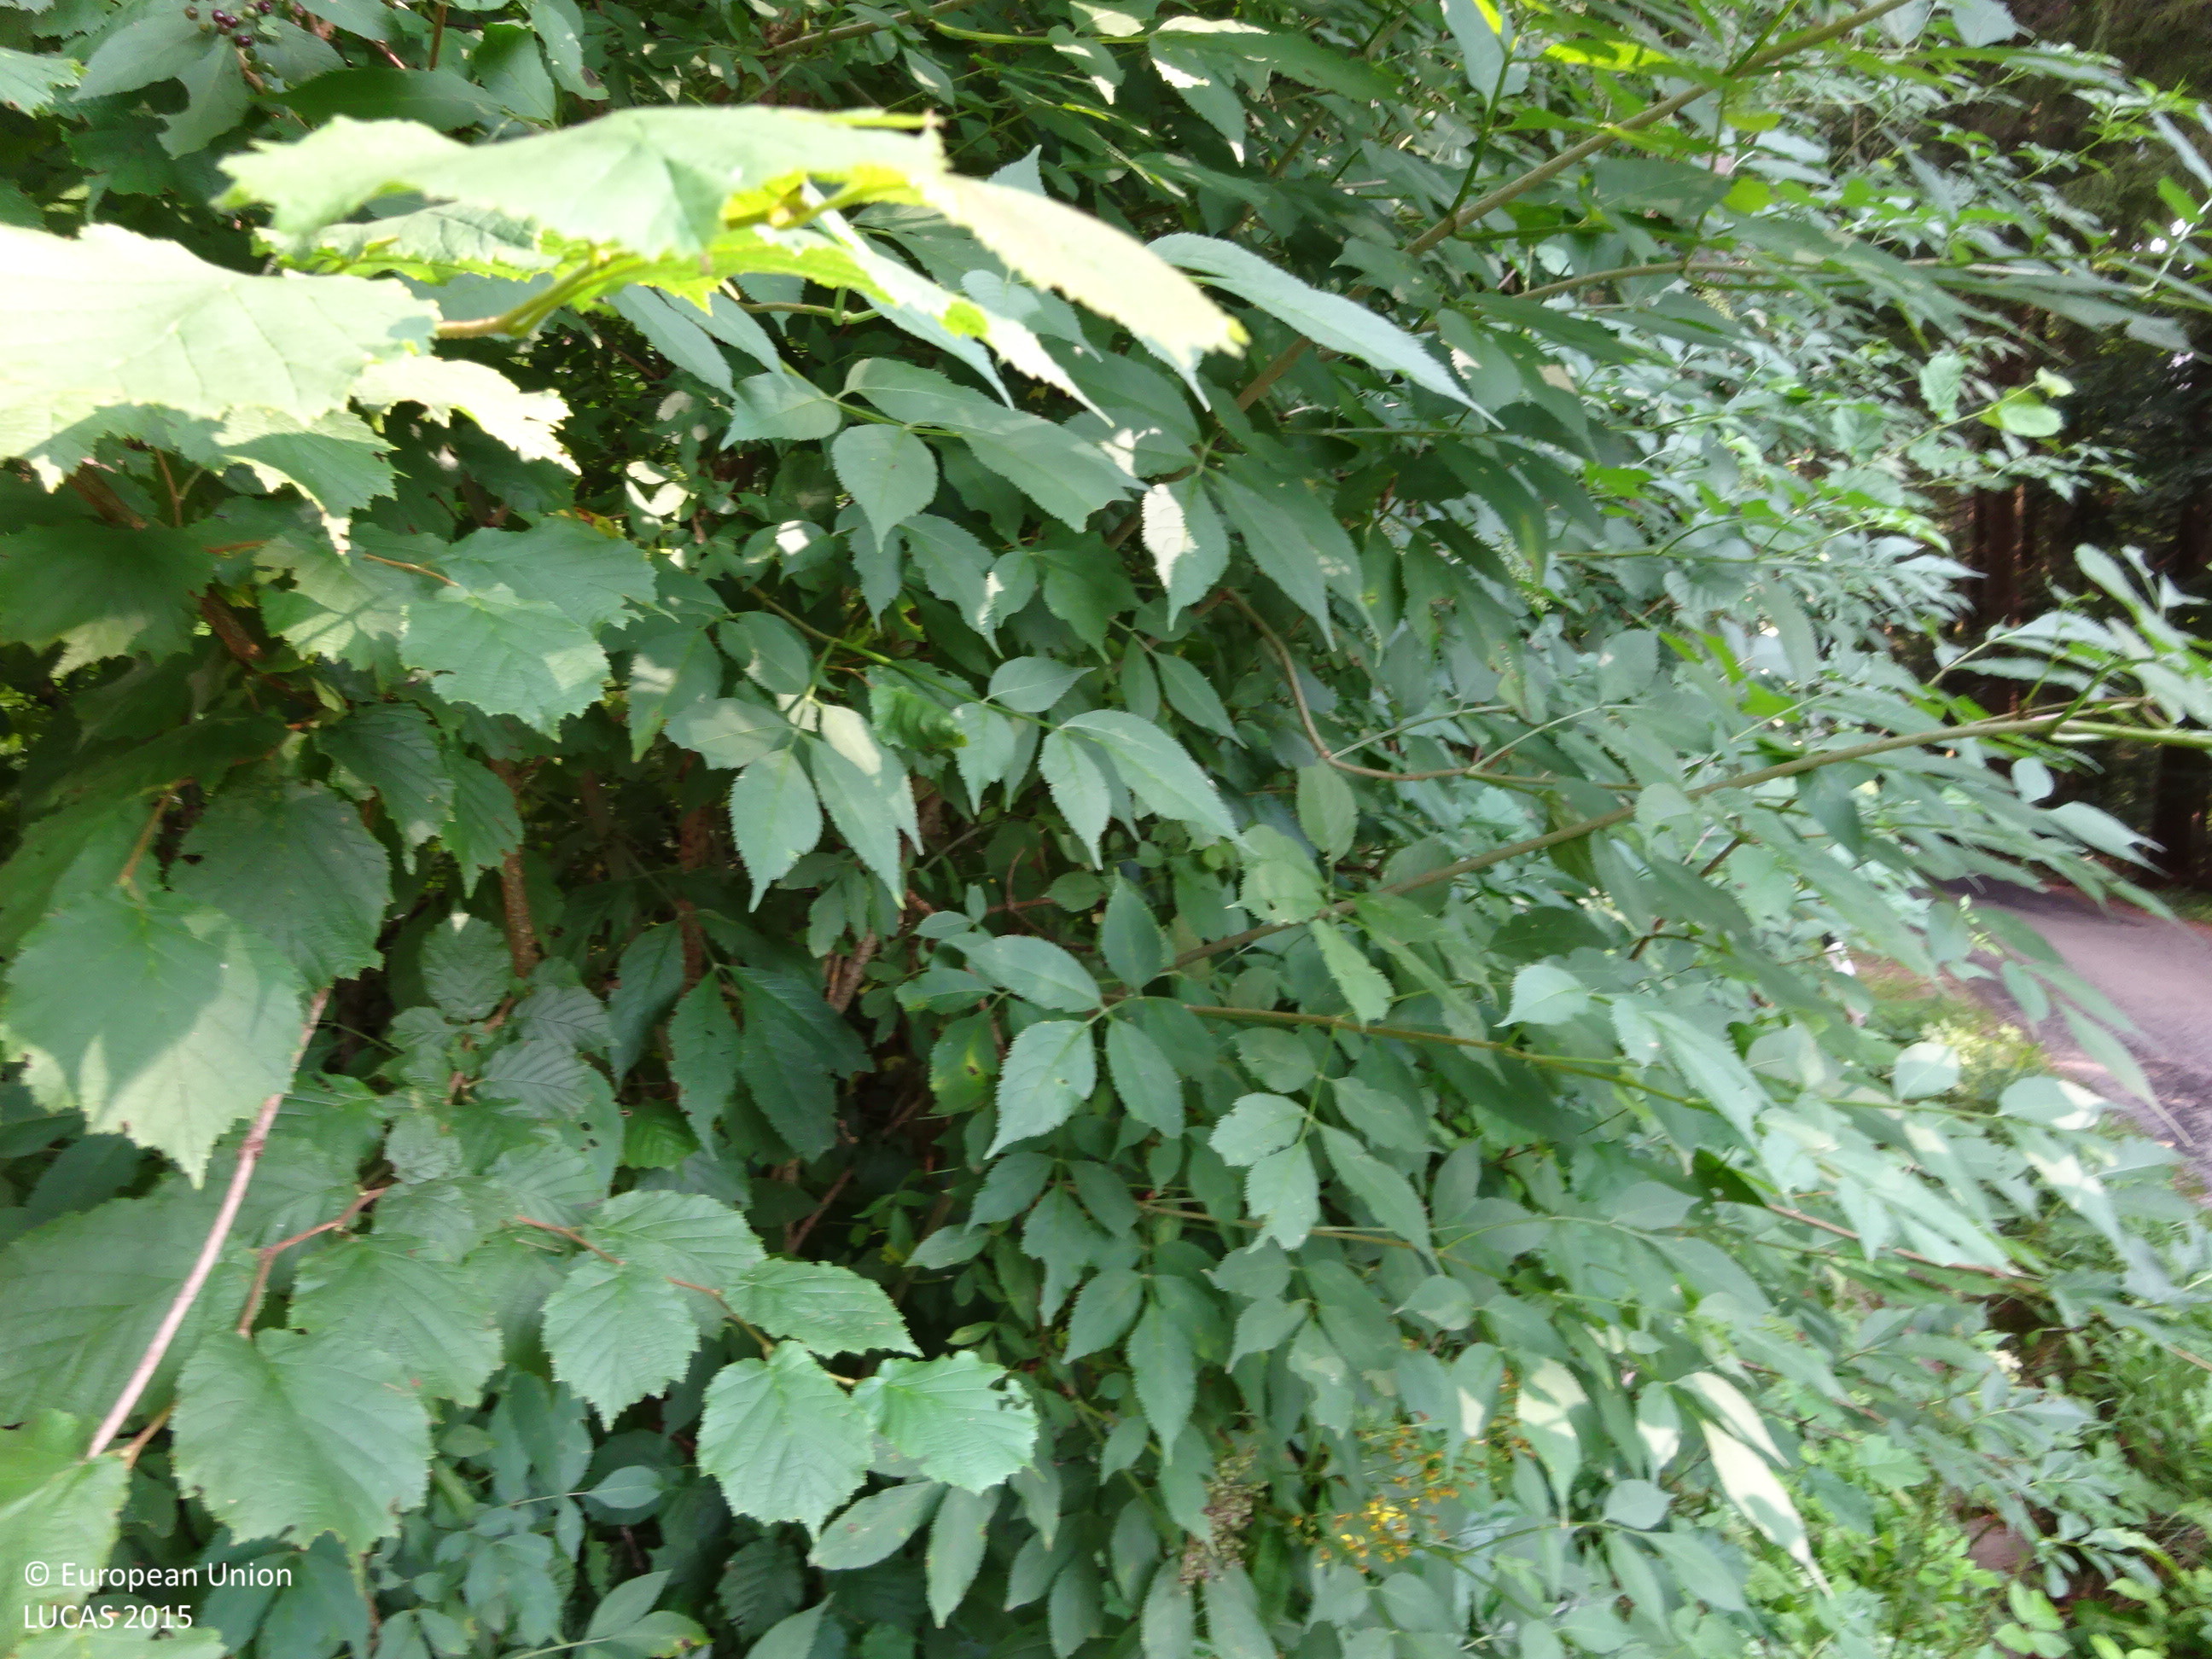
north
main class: Woodland
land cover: Spruce dominated mixed woodland
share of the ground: 10 - 25 %
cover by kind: coniferous forest trees 65 %, broadleaved forest trees 30 %, herbaceous plants 5 %
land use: Forestry
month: August
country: AT
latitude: 47.3734
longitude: 15.6825
